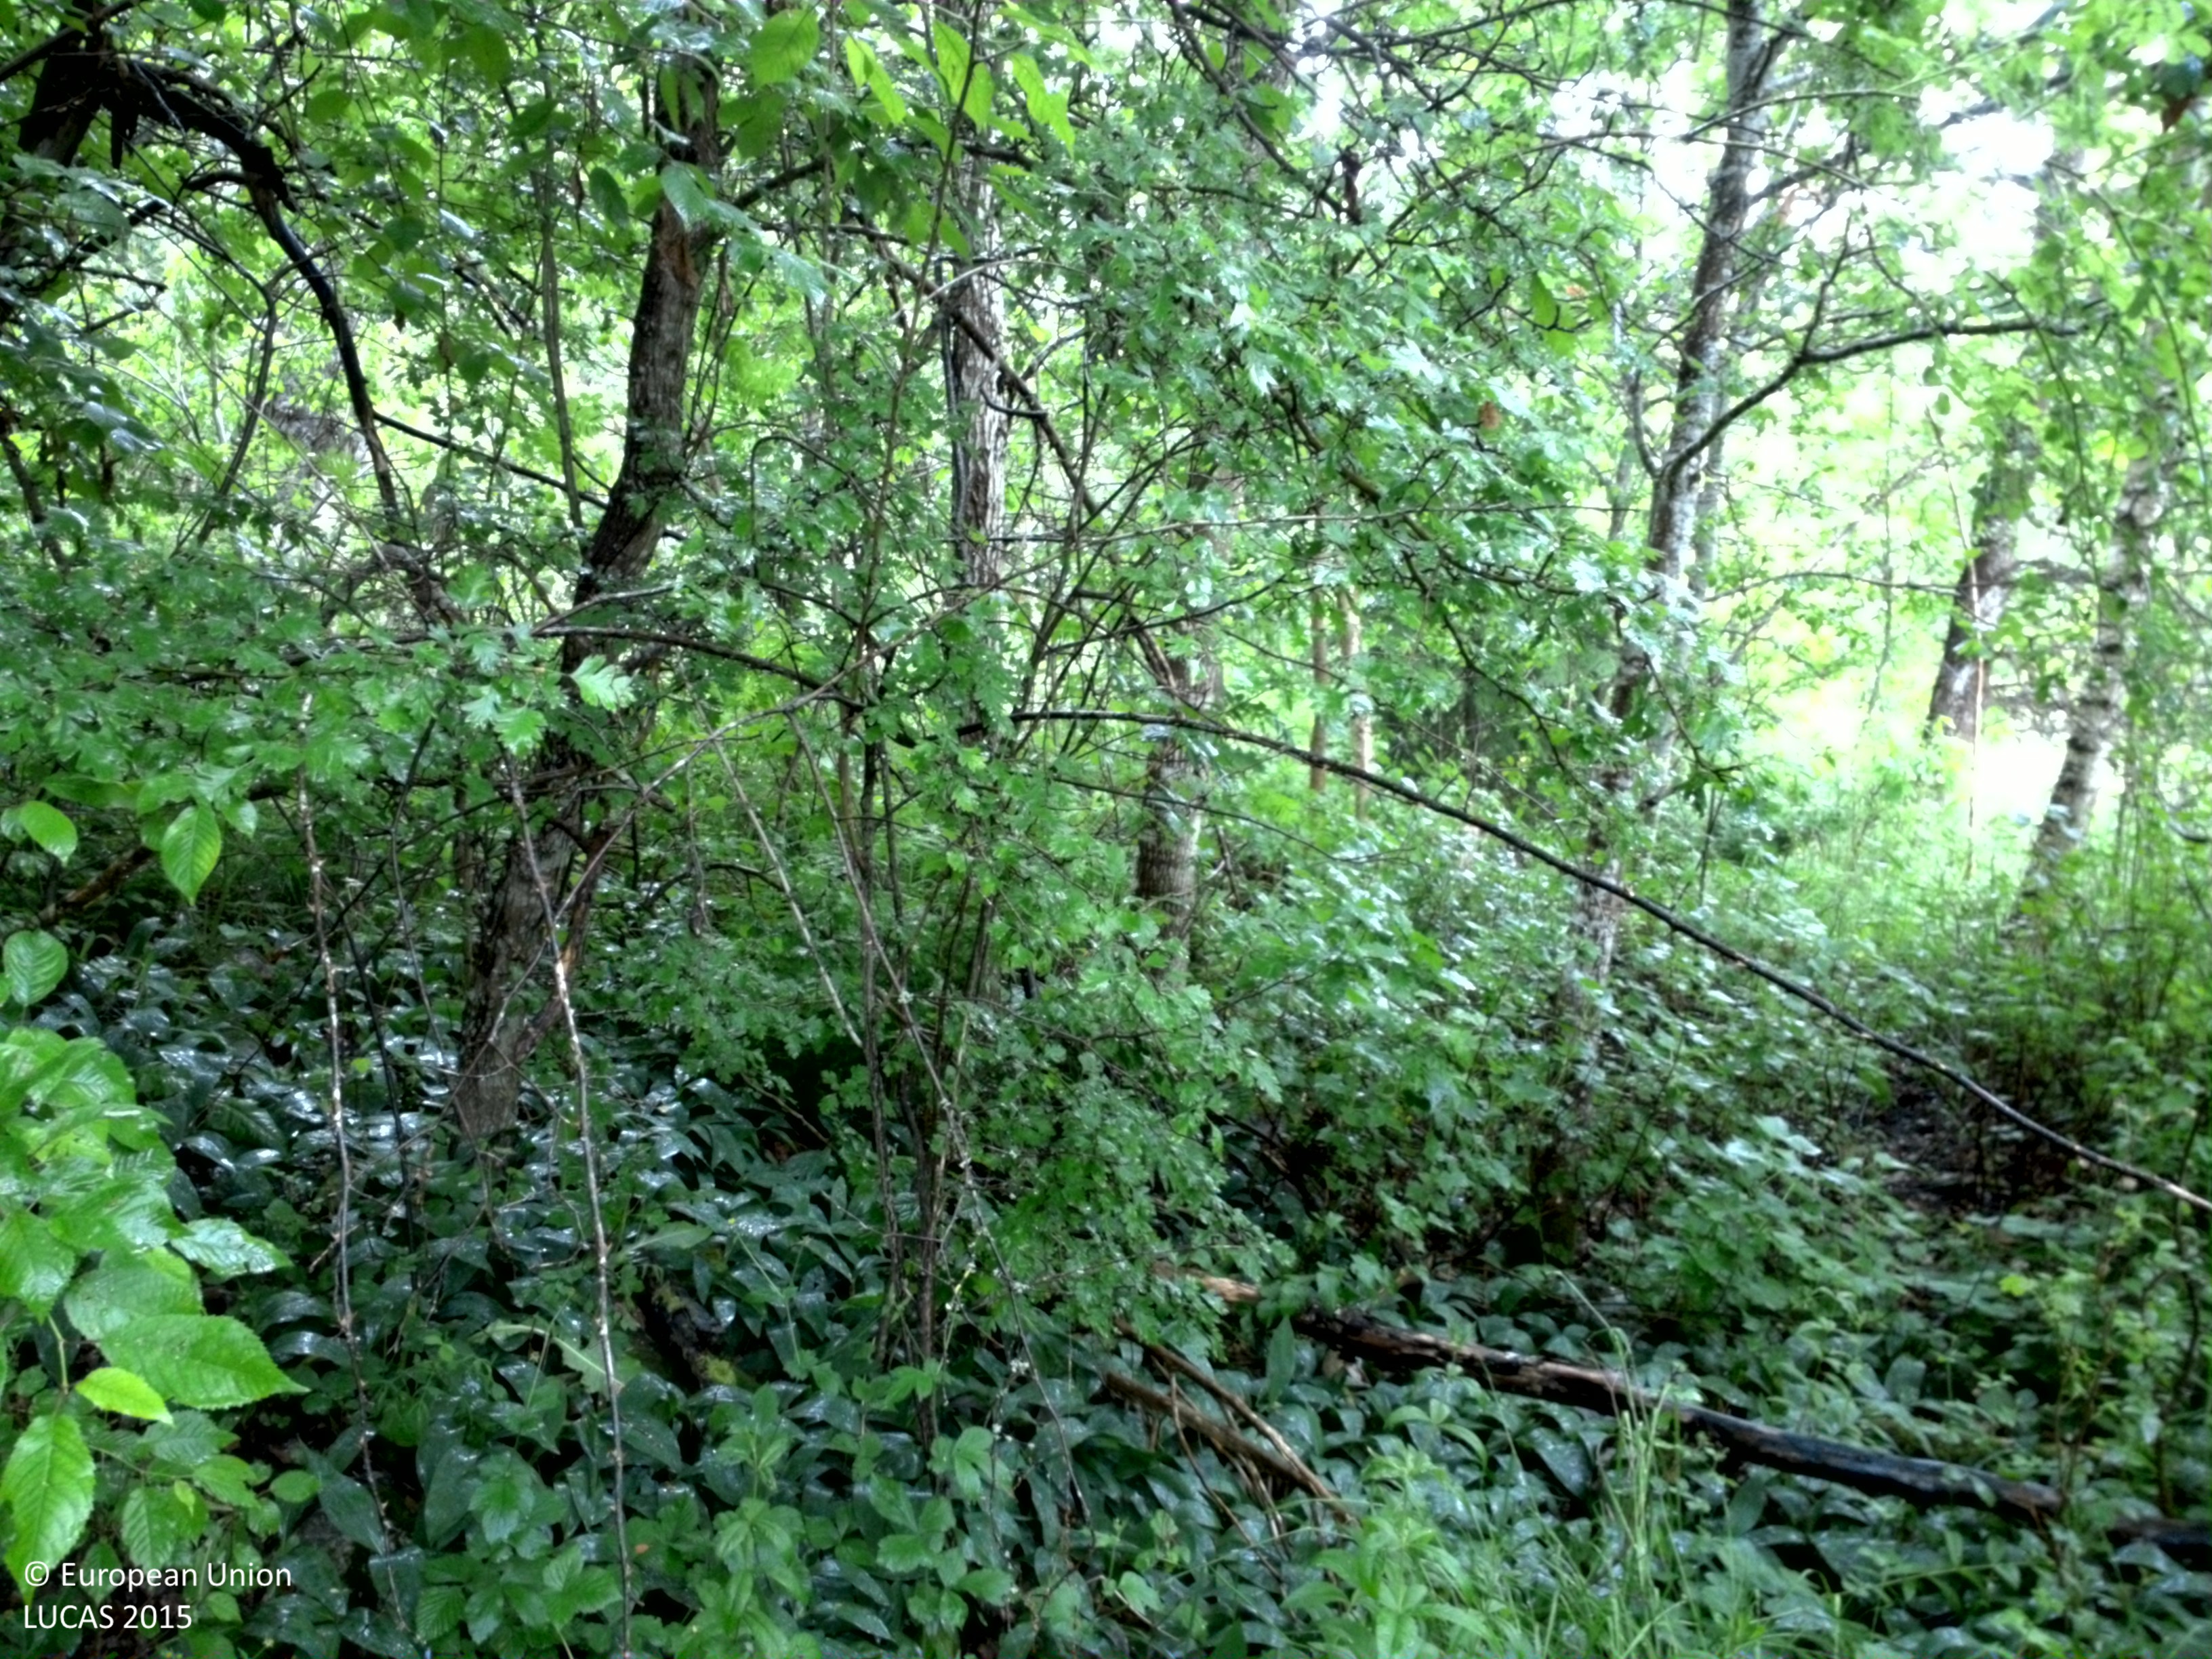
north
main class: Woodland
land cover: Broadleaved woodland
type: acidophilous oak and oak-birch forest
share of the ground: > 75 %
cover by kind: broadleaved forest trees 85 %, herbaceous plants 15 %
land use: Forestry
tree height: > 5 m
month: June
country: SE
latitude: 58.7243
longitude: 15.3987
